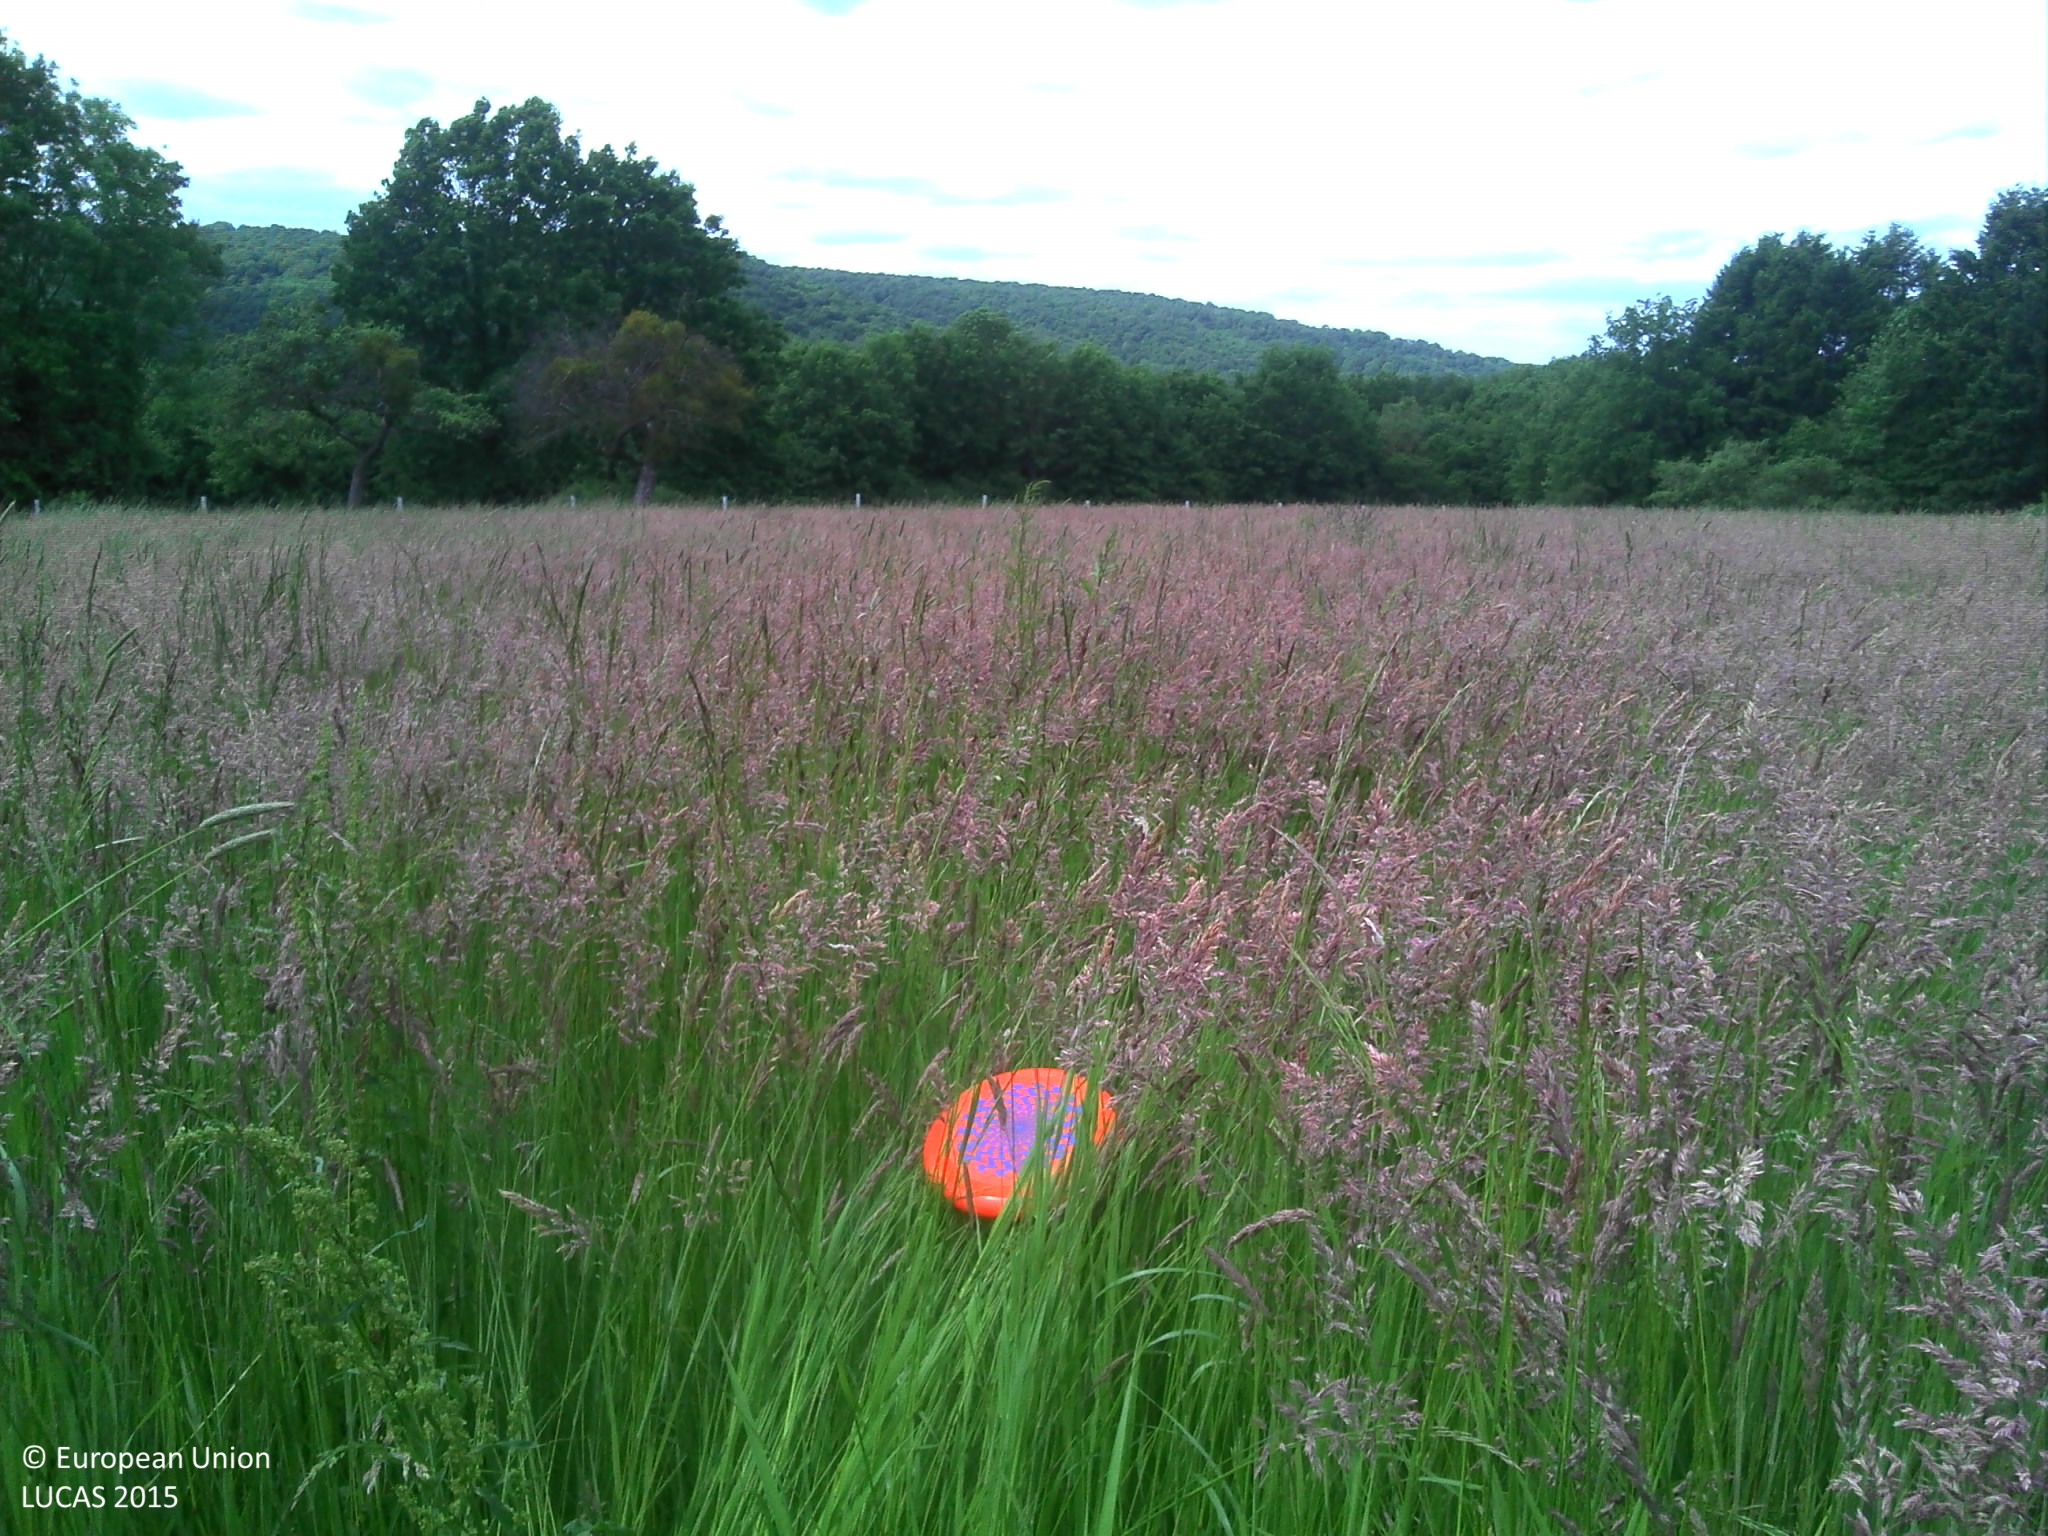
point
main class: Grassland
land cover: Grassland without tree/shrub cover
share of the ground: > 75 %
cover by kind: herbaceous plants 100 %
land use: Agriculture (excluding fallow land and kitchen gardens)
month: May
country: BE
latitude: 50.1751
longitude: 4.8300
